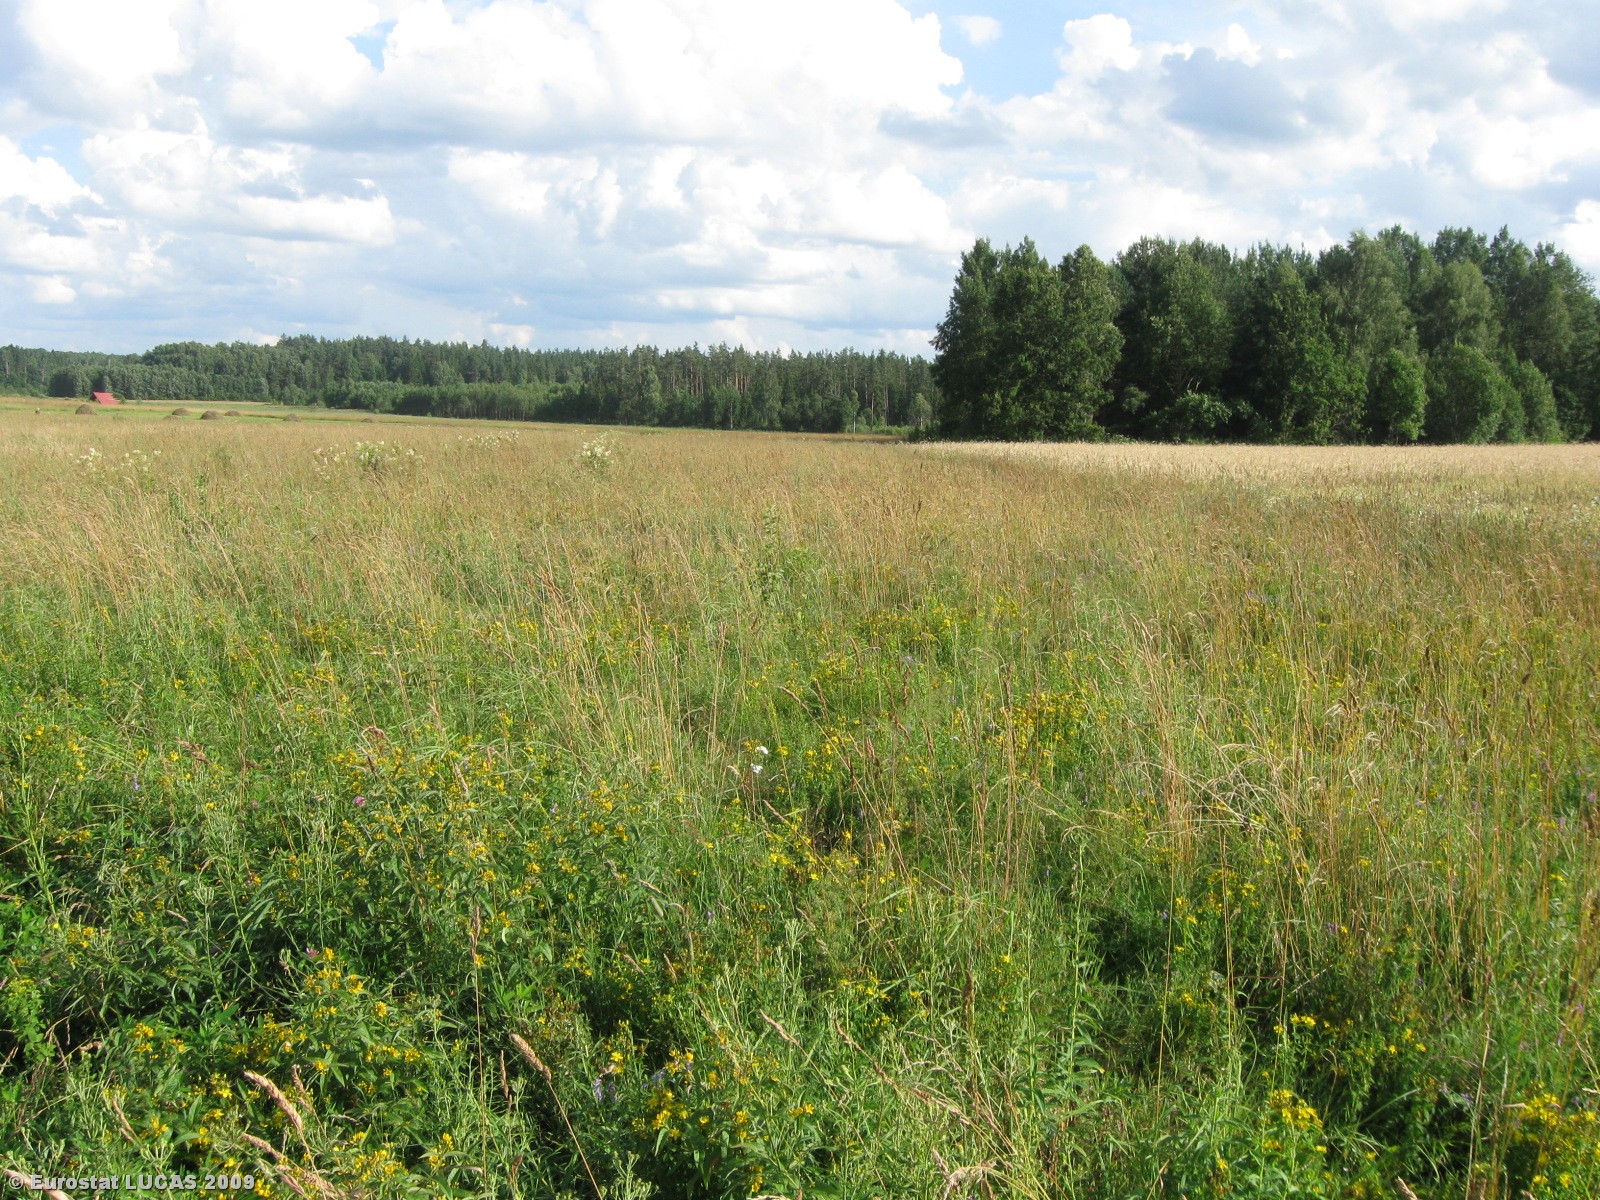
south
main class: Grassland
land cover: Grassland without tree/shrub cover
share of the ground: > 75 %
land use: Agriculture (excluding fallow land and kitchen gardens)
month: July
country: LT
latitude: 54.4885
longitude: 25.3285
